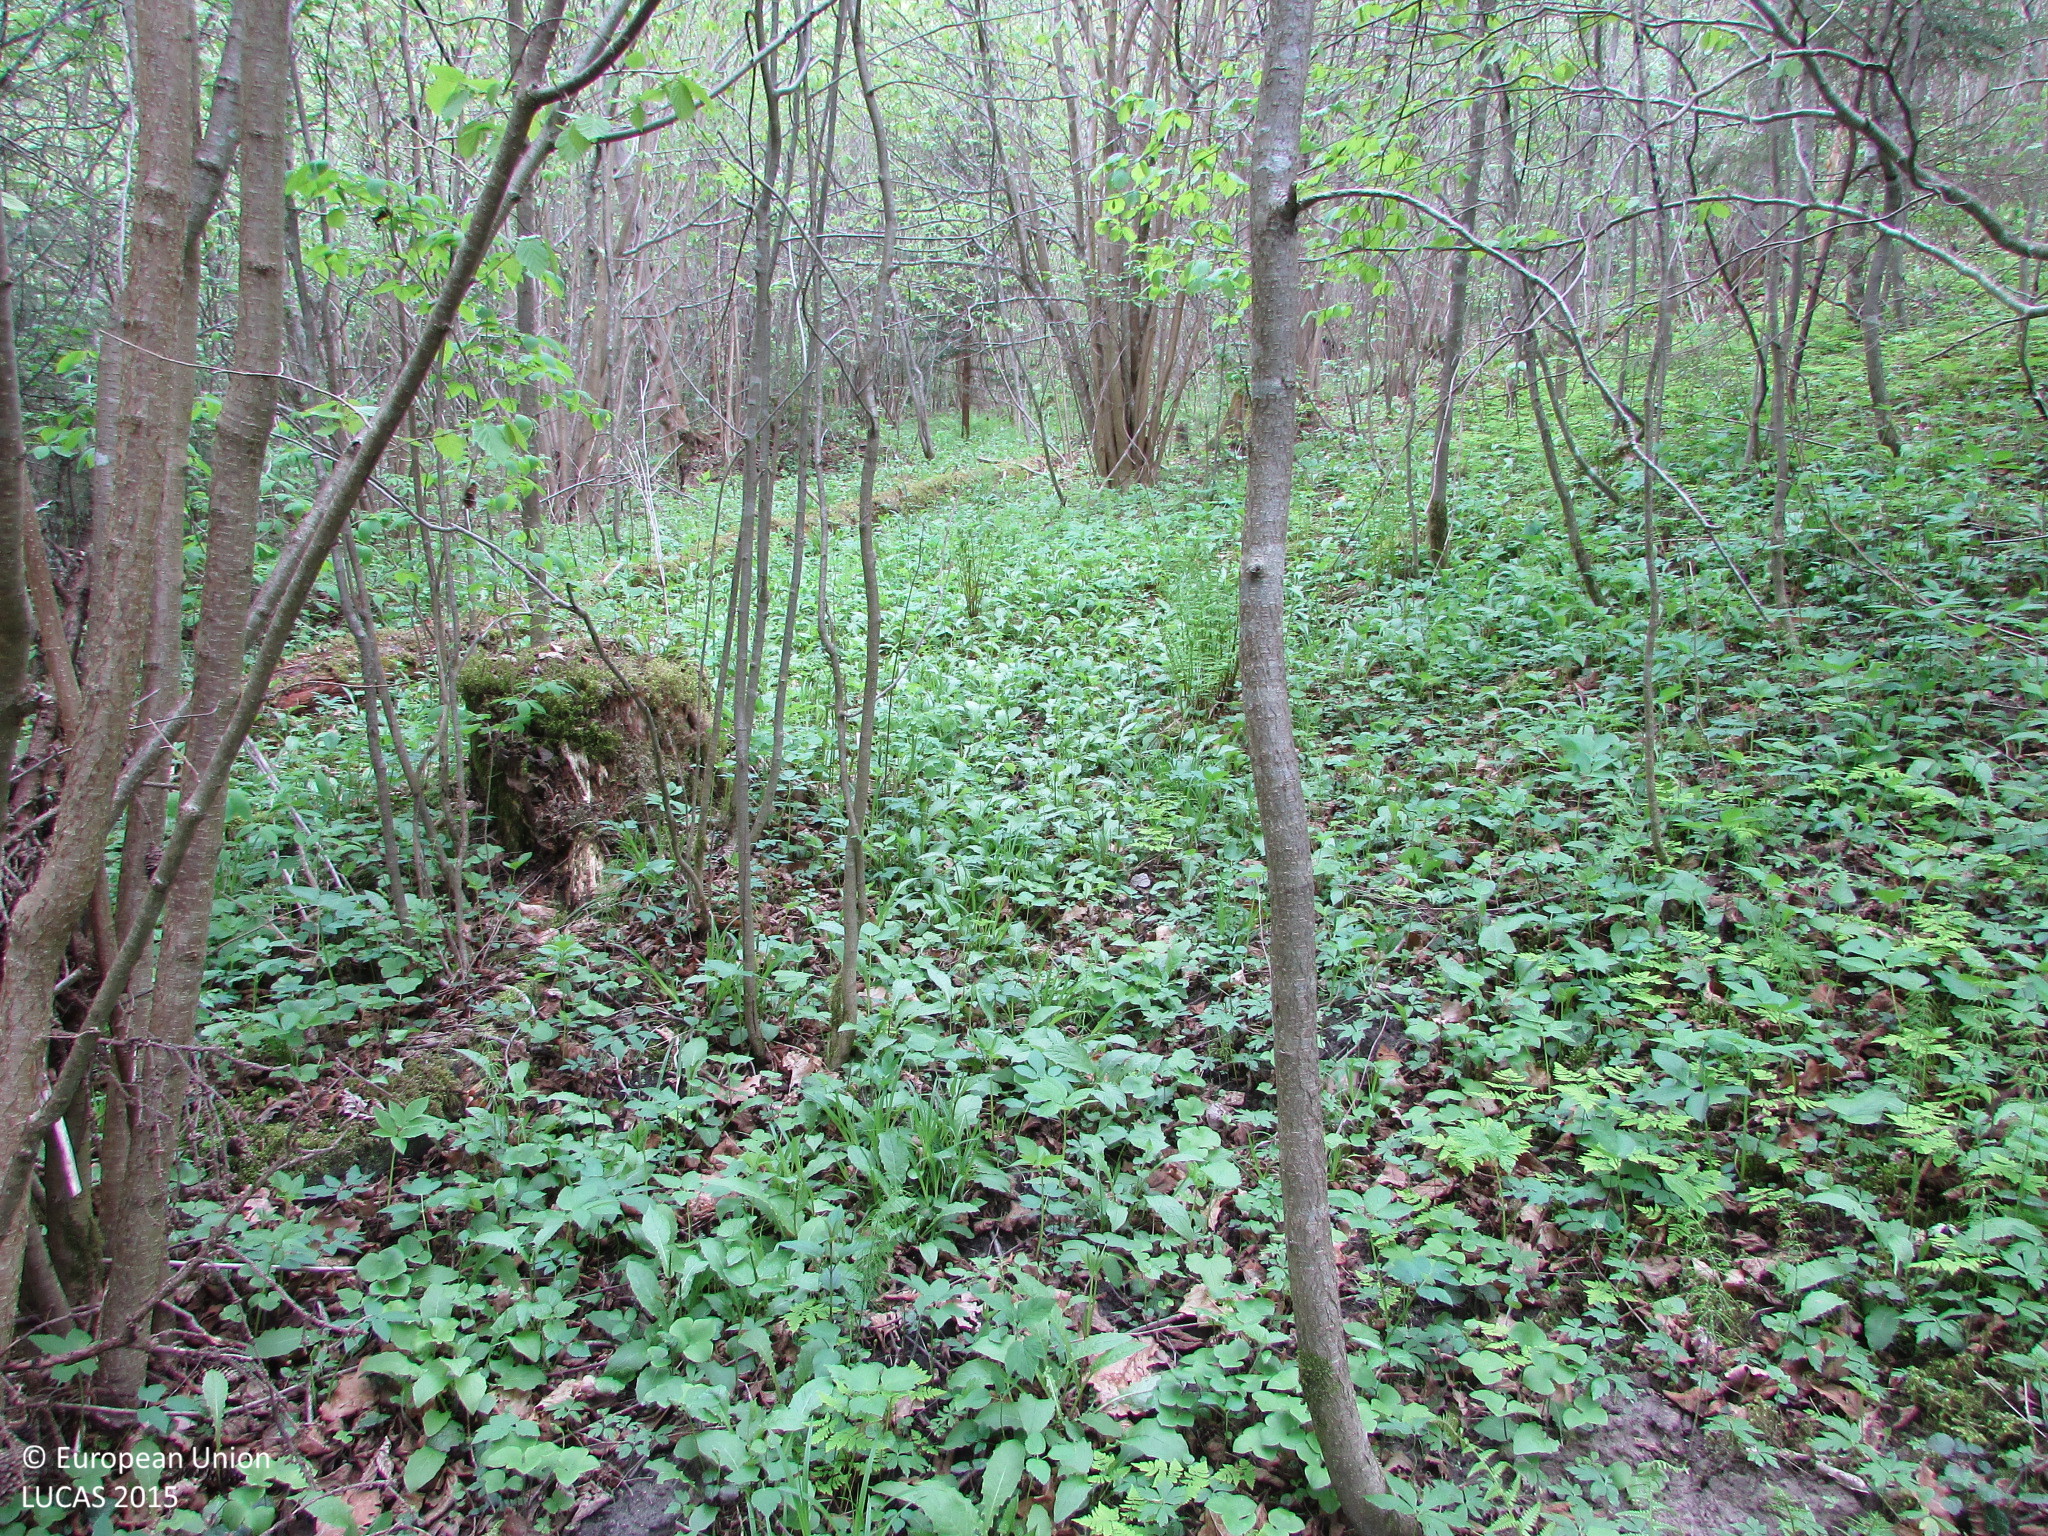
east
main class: Woodland
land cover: Broadleaved woodland
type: floodplain forest
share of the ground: > 75 %
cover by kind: broadleaved forest trees 80 %, herbaceous plants 10 %, unconsolidated bare surface 5 %
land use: Forestry
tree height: > 5 m
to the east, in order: Broadleaved woodland; Spruce dominated mixed woodland; Spruce dominated coniferous woodland; Spruce dominated mixed woodland; Spontaneously vegetated surfaces; Broadleaved woodland; Groves; Spontaneously vegetated surfaces
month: May
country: LV
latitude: 56.1665
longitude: 27.3926
